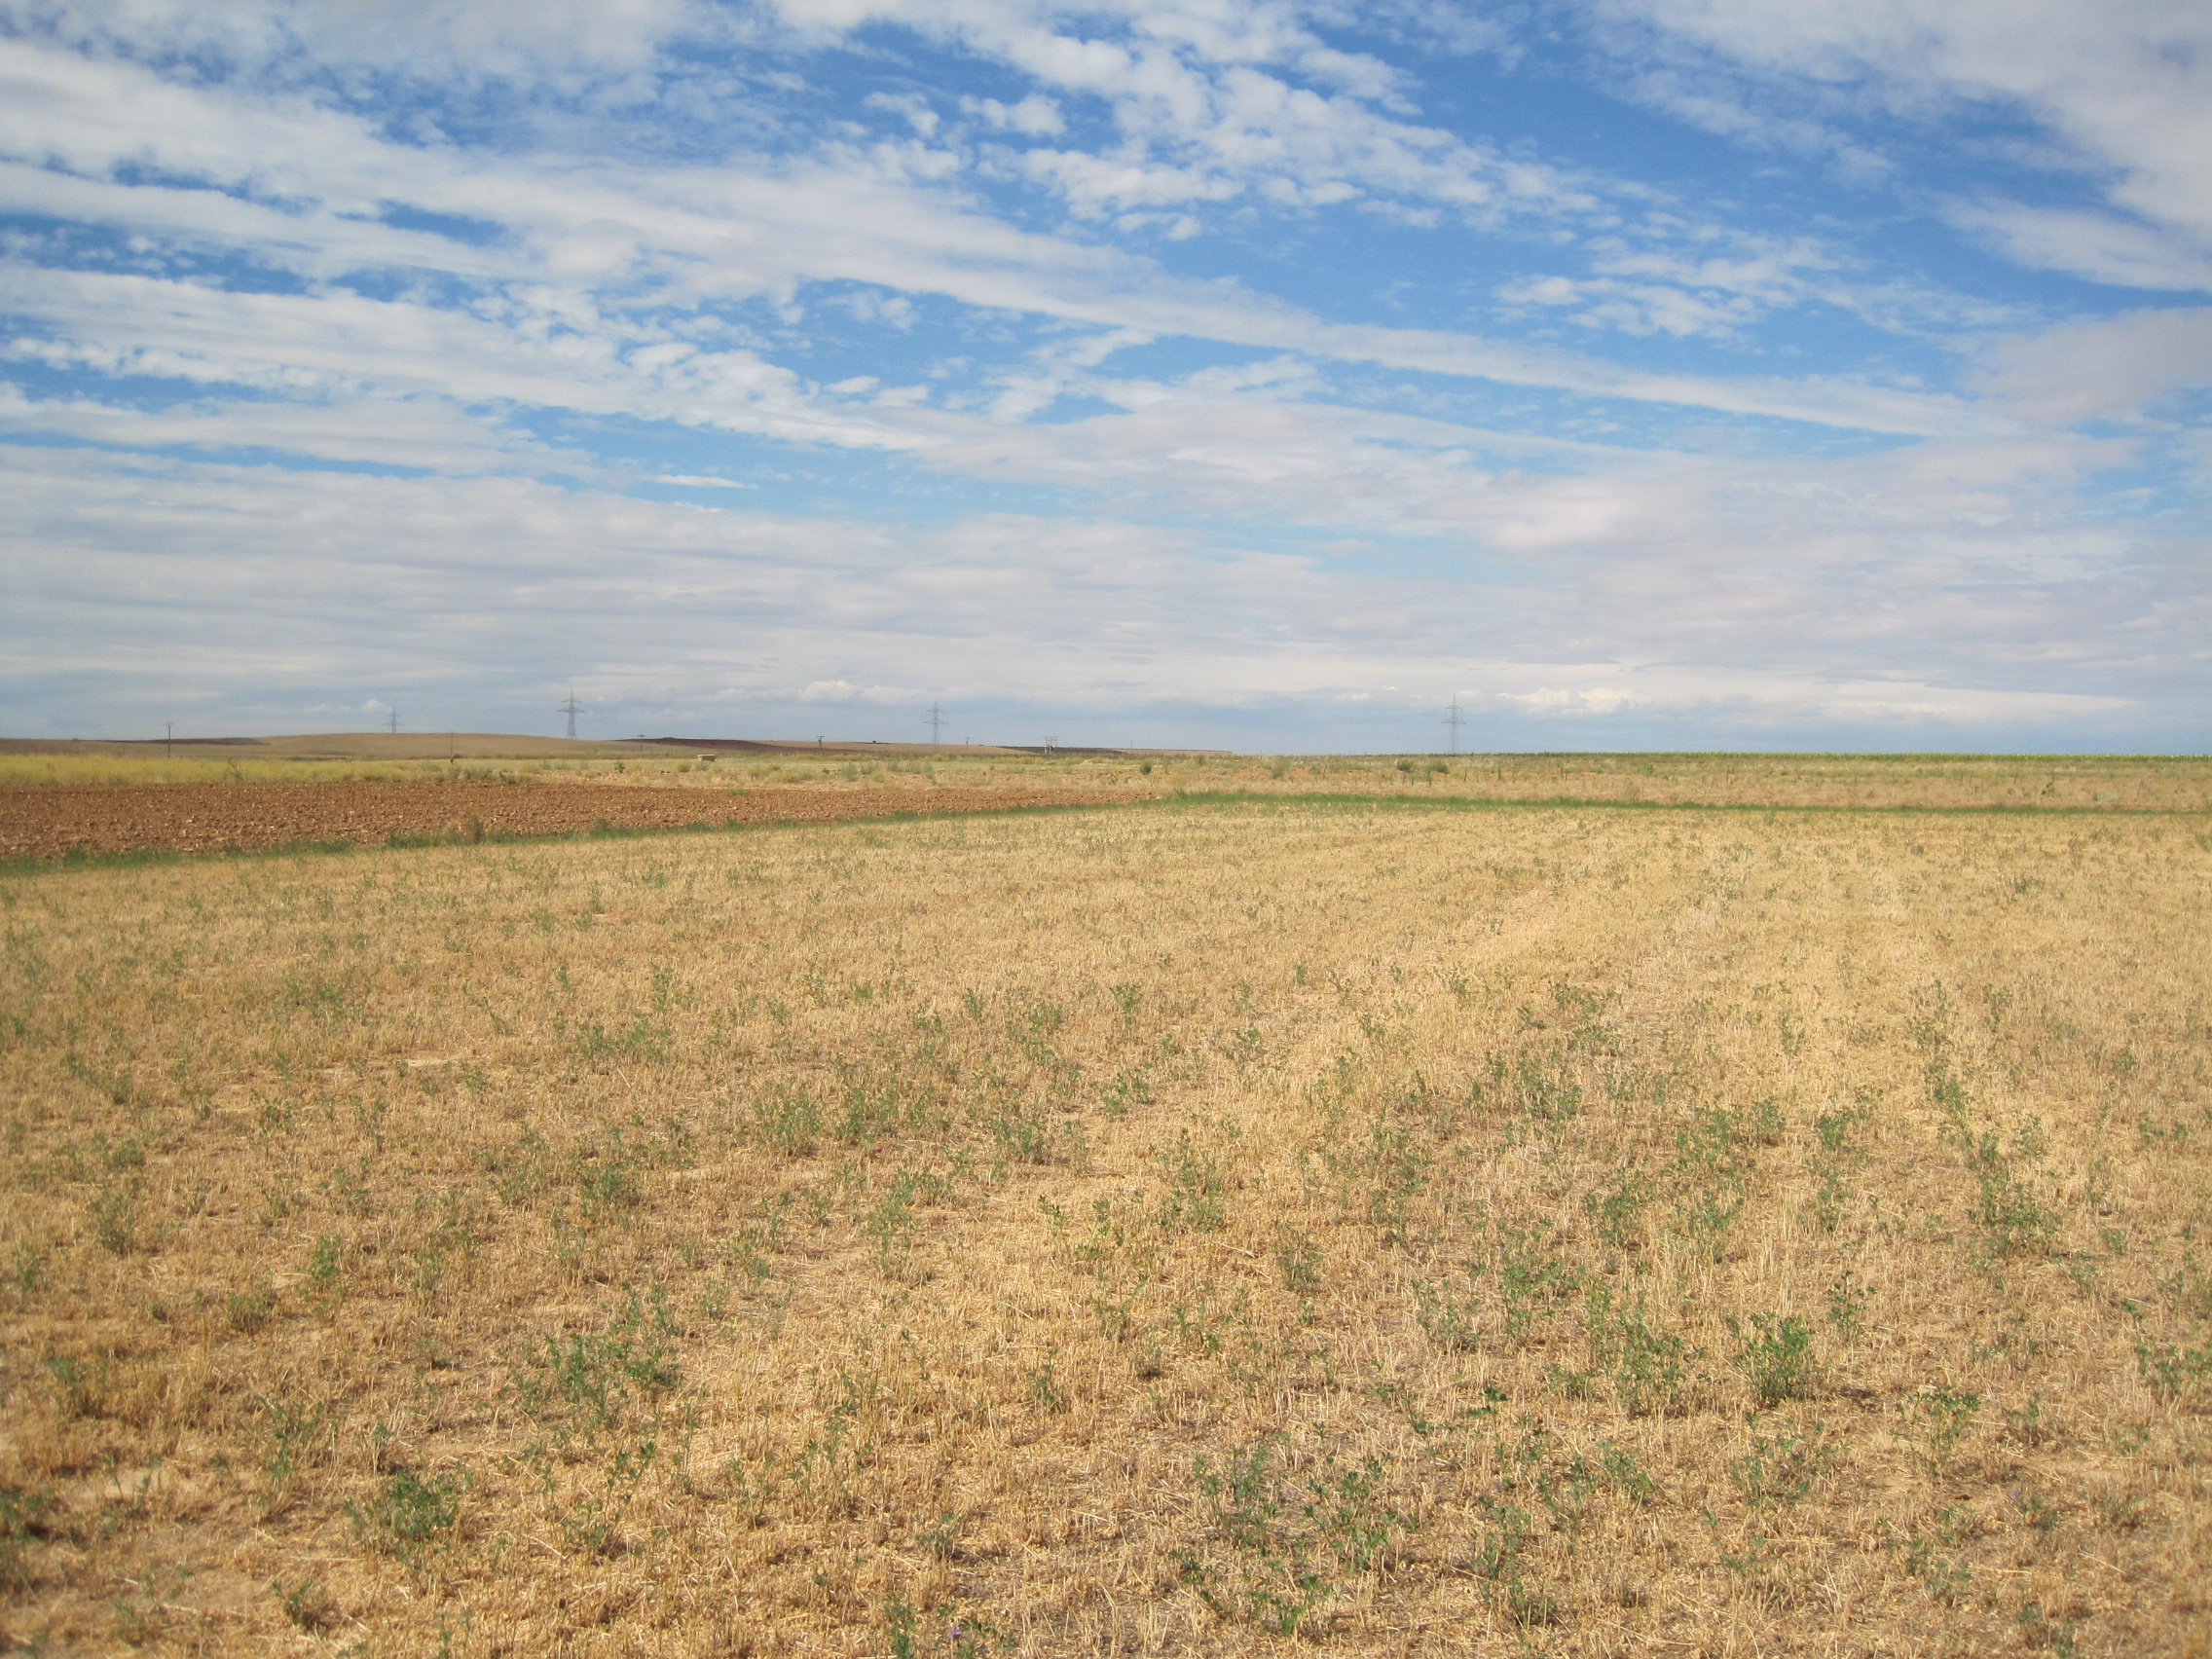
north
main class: Cropland
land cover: Lucerne
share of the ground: 25 - 50 %
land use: Agriculture (excluding fallow land and kitchen gardens)
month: July
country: ES
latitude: 42.0449
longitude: -5.4675
